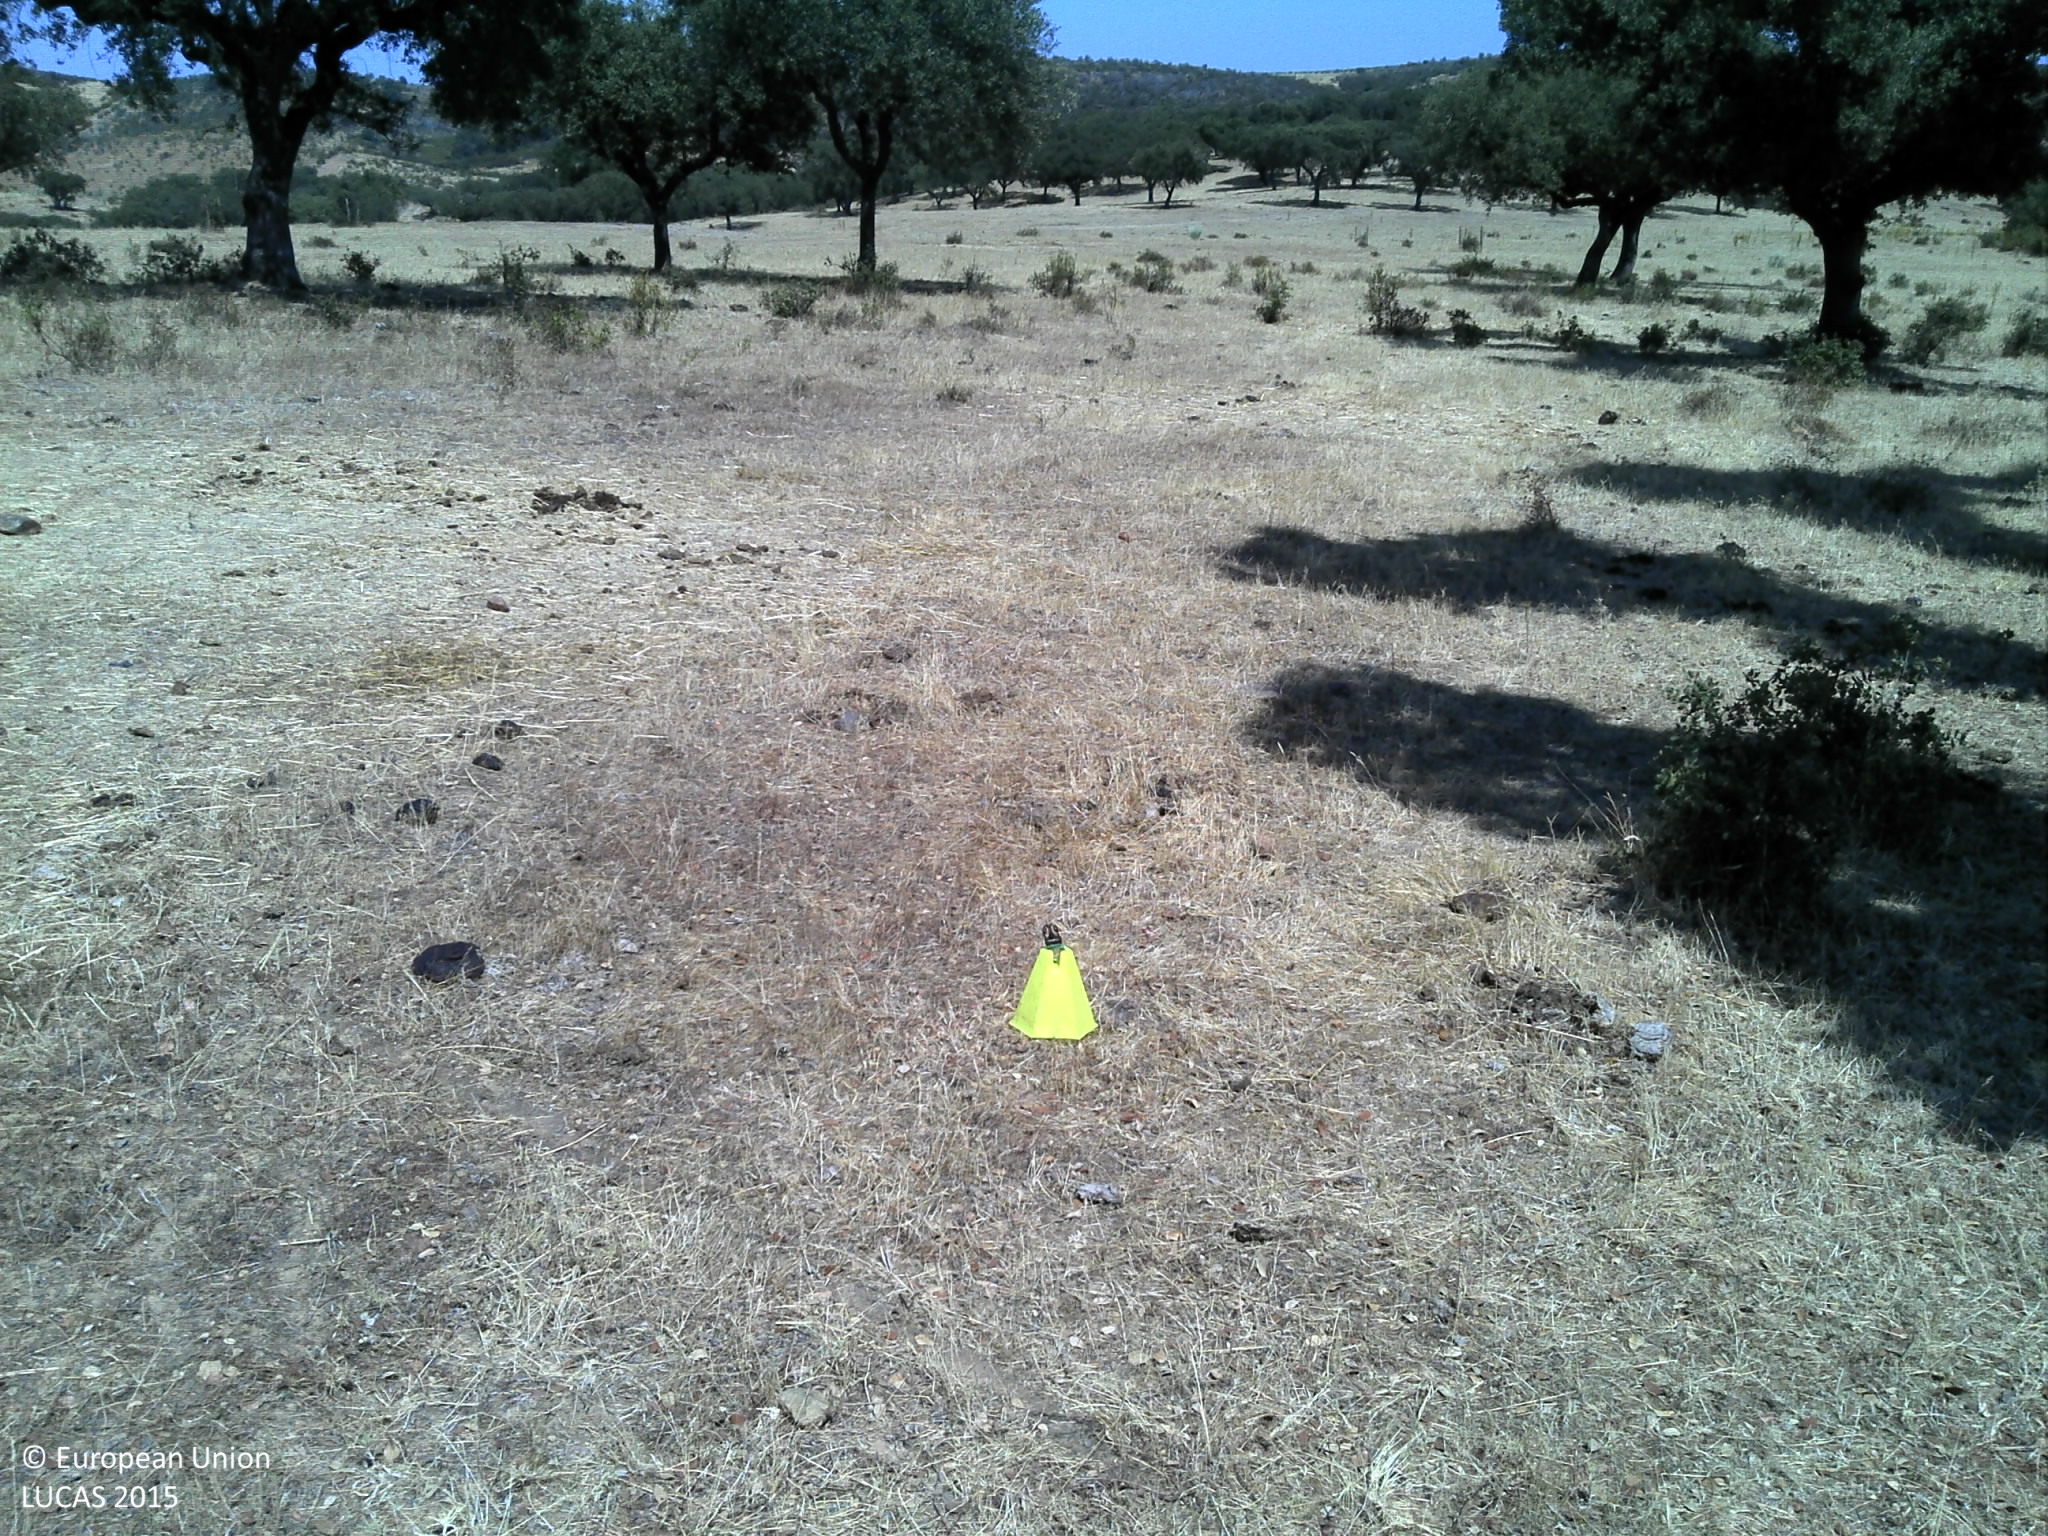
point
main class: Woodland
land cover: Broadleaved woodland
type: broadleaved evergreen forest
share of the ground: 25 - 50 %
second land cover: Grassland without tree/shrub cover
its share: 10 - 25 %
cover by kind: unconsolidated bare surface 50 %, broadleaved forest trees 25 %, herbaceous plants 25 %
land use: Forestry
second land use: Agriculture (excluding fallow land and kitchen gardens)
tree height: > 5 m
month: July
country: PT
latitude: 38.6777
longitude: -7.5157
